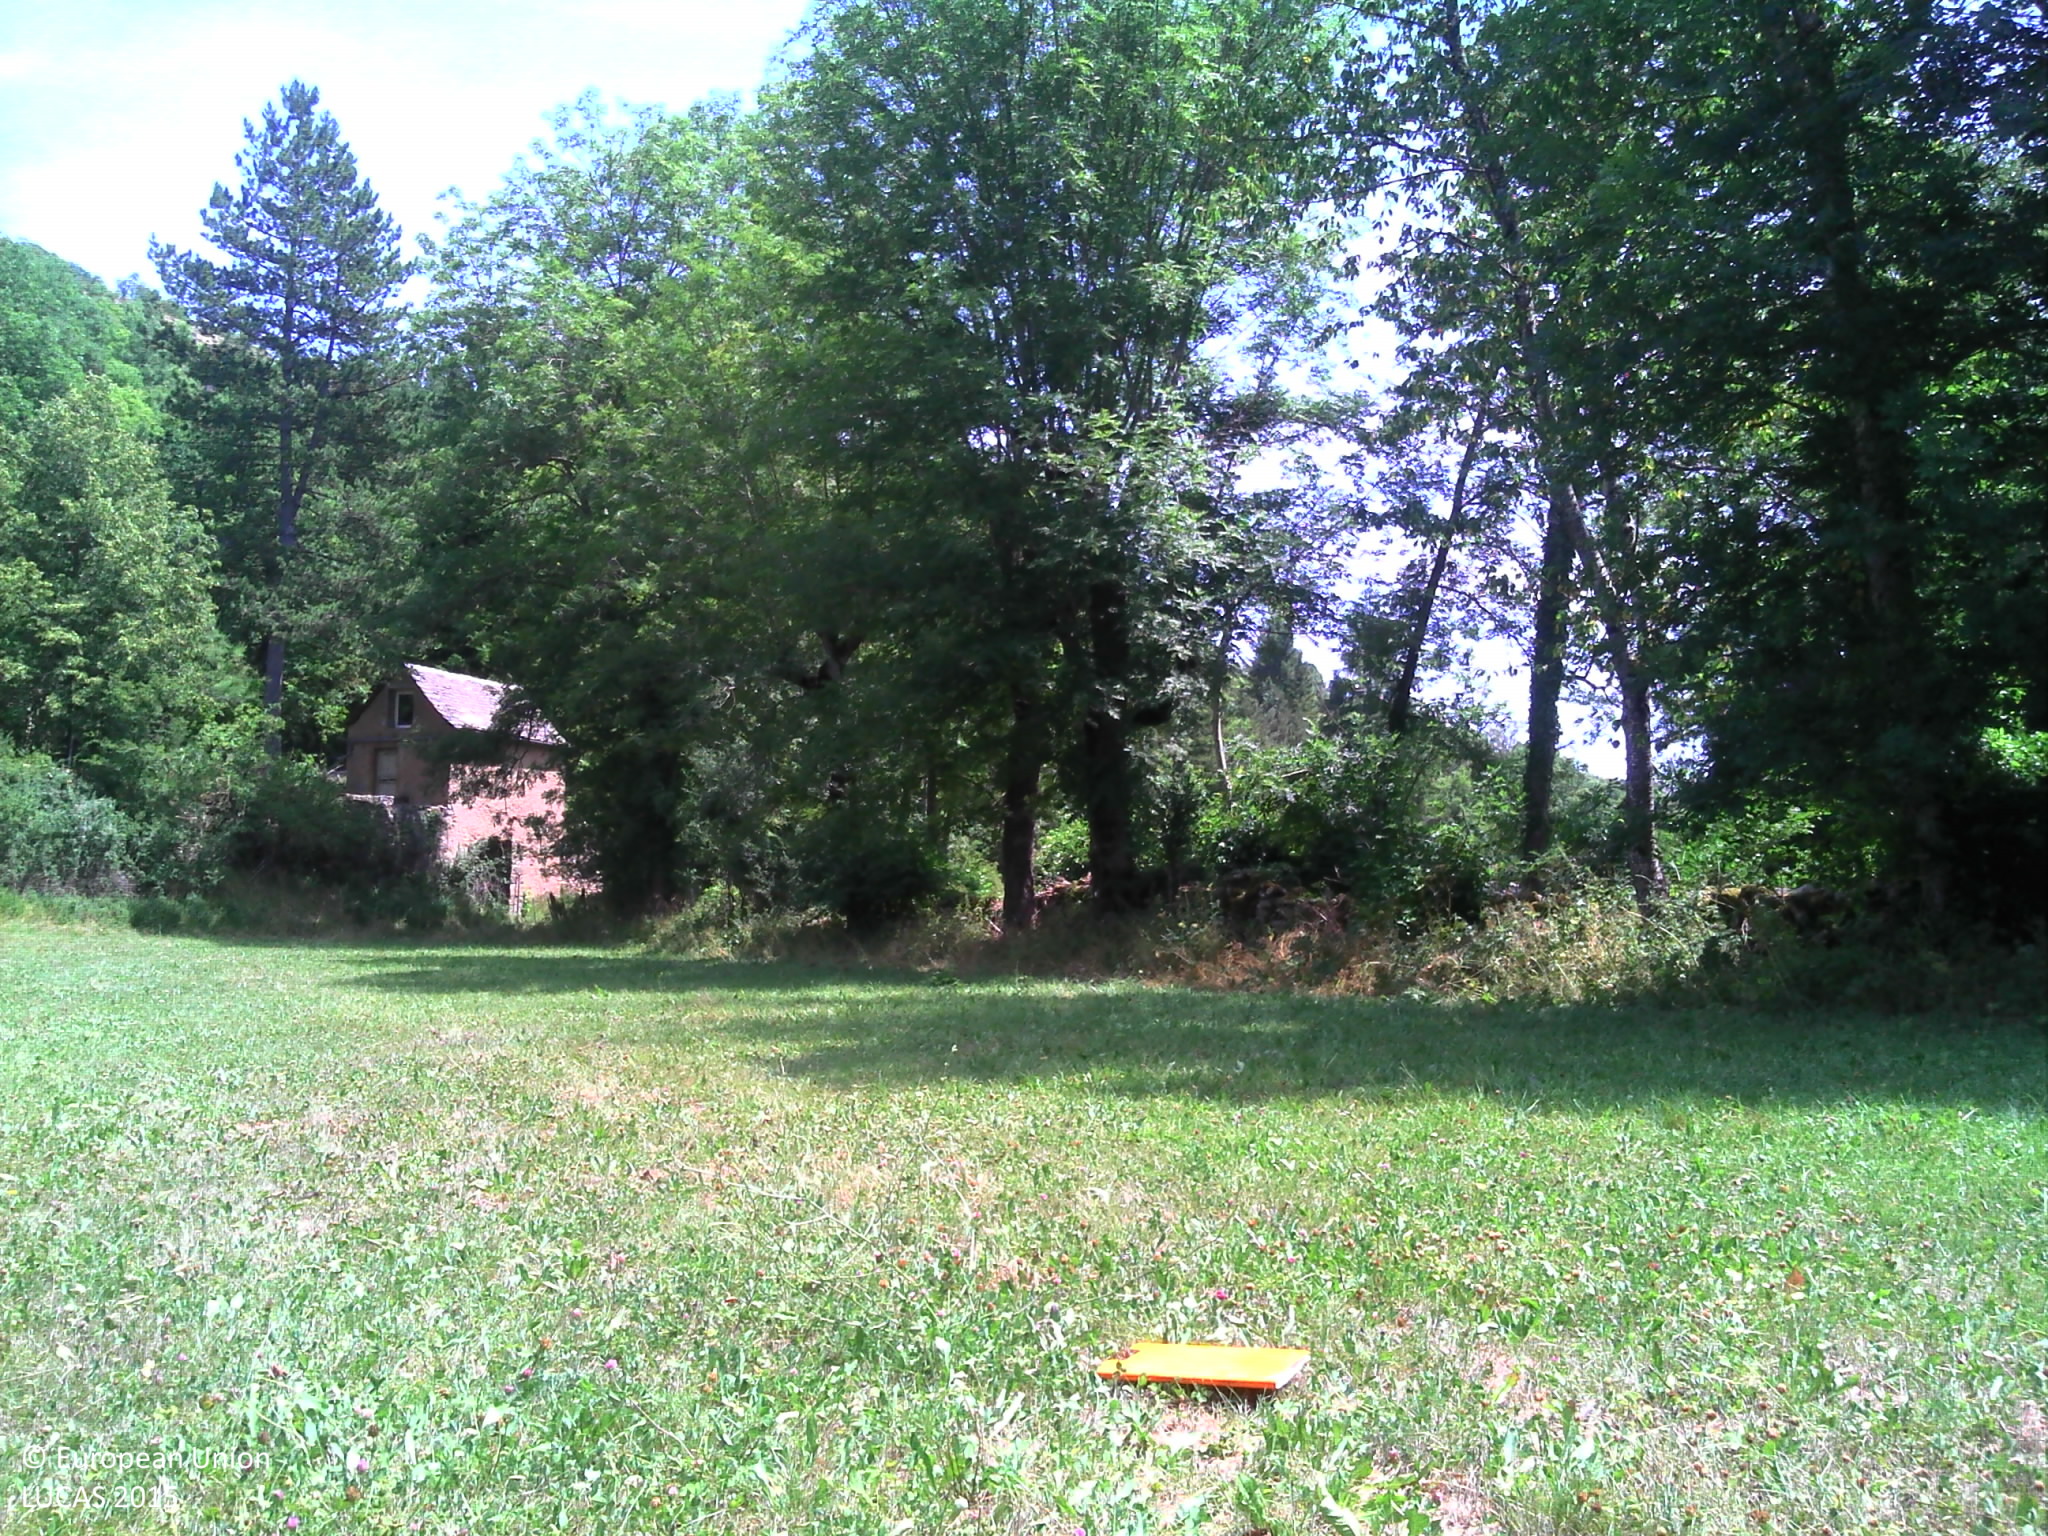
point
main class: Grassland
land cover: Grassland without tree/shrub cover
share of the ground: > 75 %
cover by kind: herbaceous plants 100 %
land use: Agriculture (excluding fallow land and kitchen gardens)
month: July
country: FR
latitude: 44.5481
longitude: 3.2703
